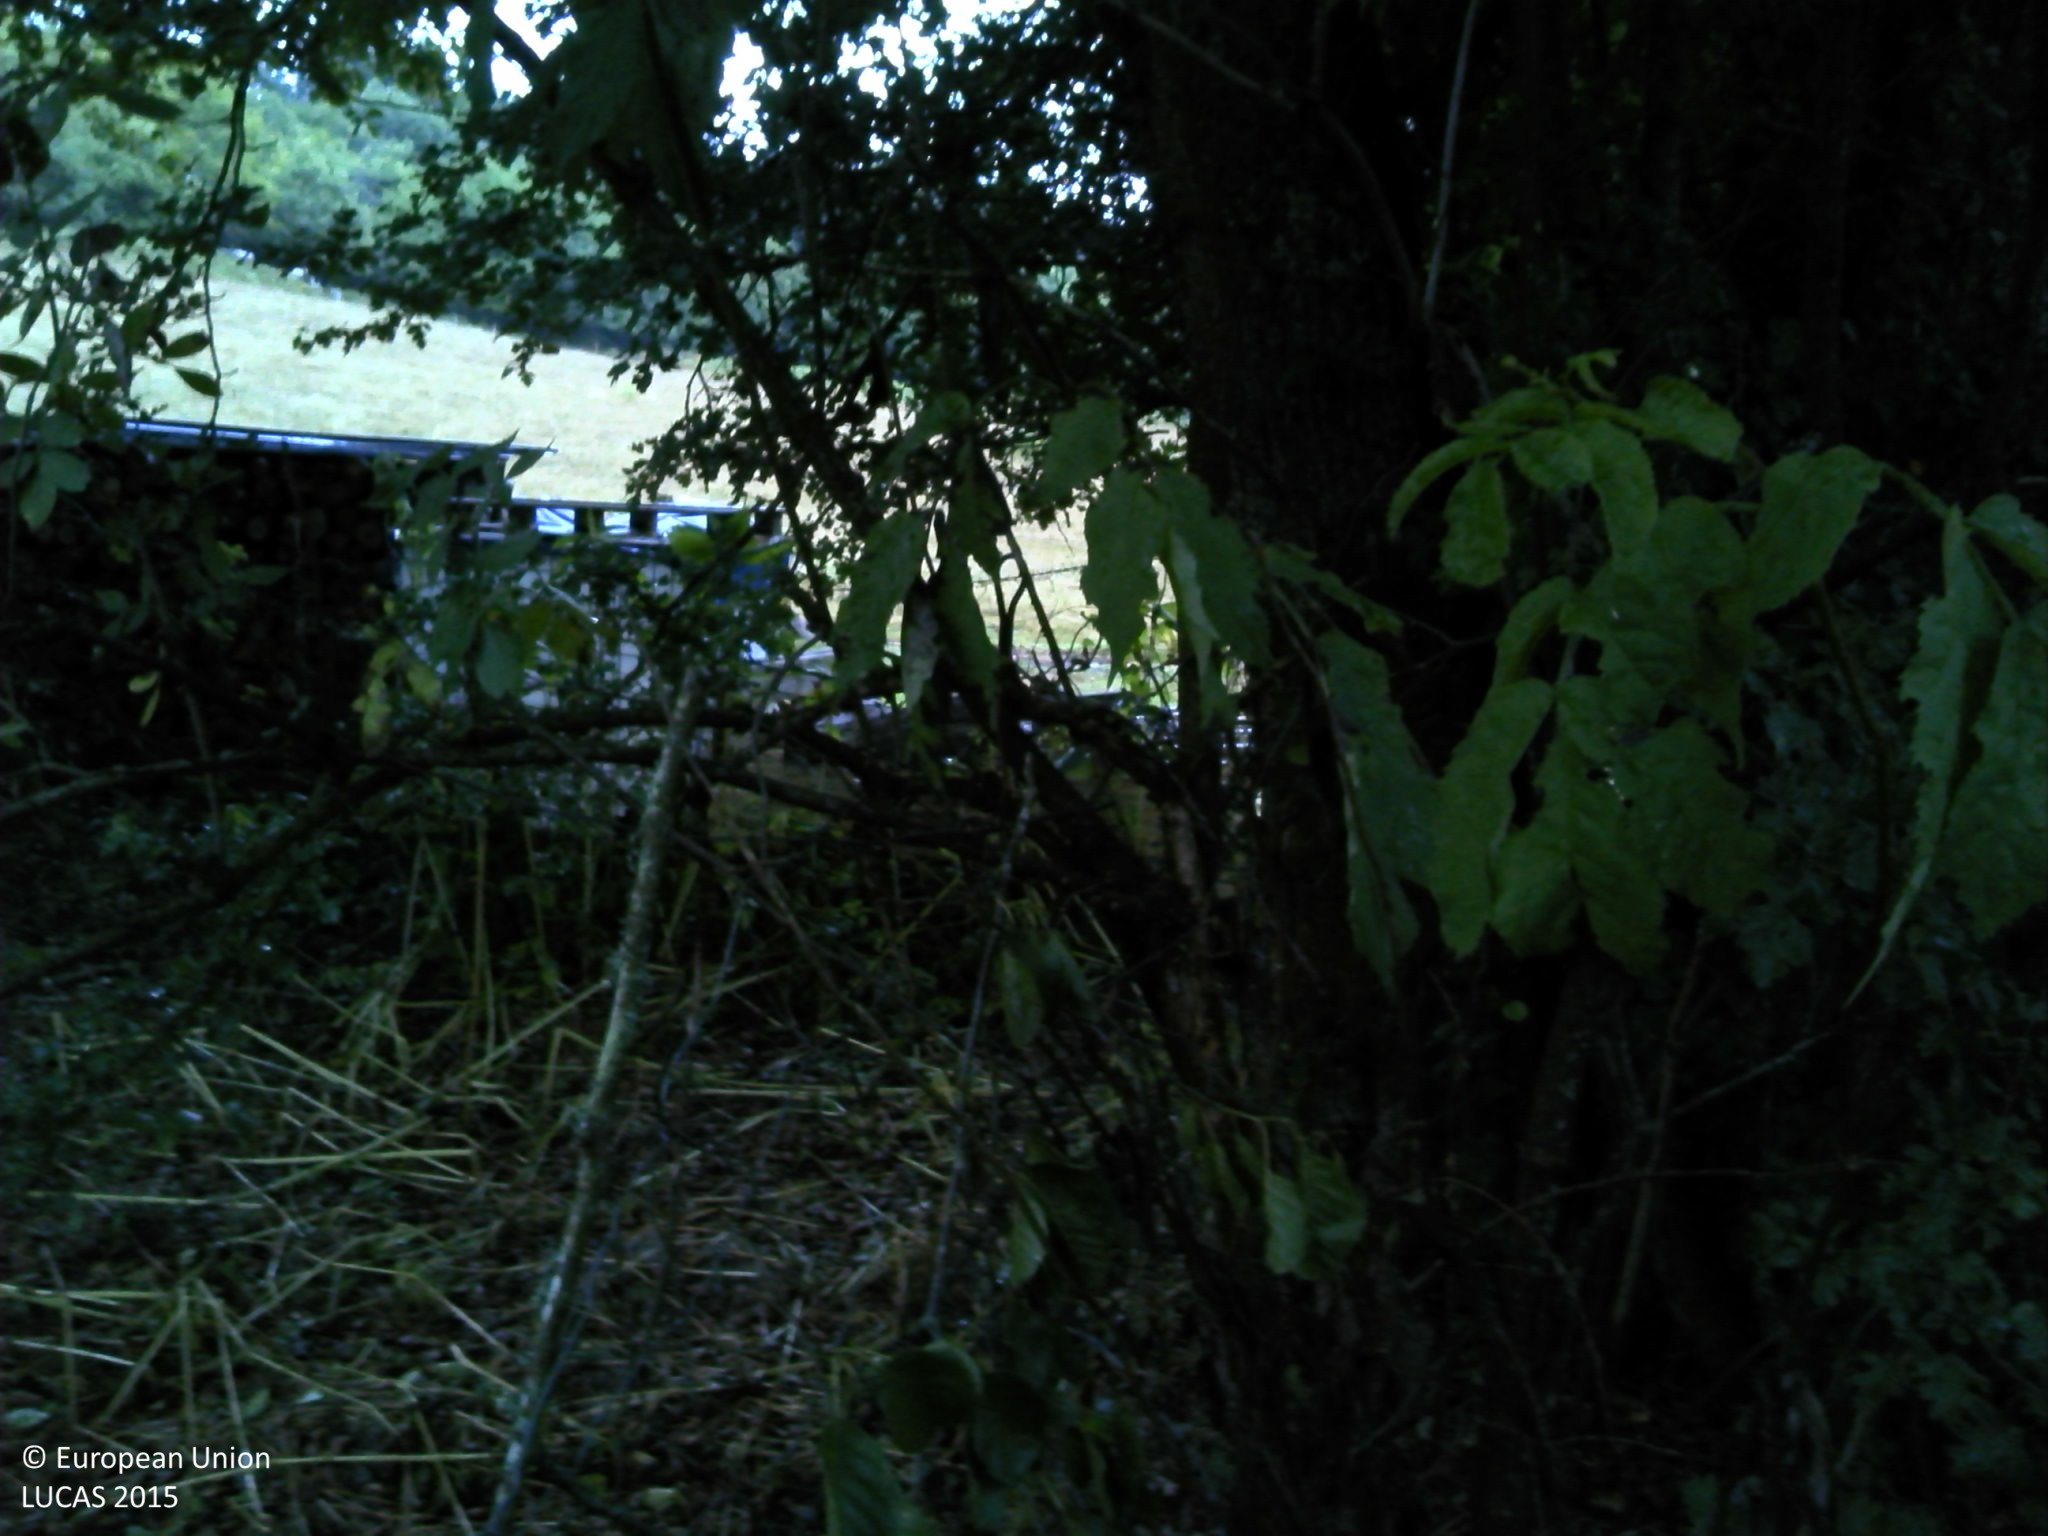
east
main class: Grassland
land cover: Grassland with sparse tree/shrub cover
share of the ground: > 75 %
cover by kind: herbaceous plants 95 %, broadleaved forest trees 5 %
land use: Agriculture (excluding fallow land and kitchen gardens)
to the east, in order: Grassland with sparse tree/shrub cover; Fences; Grassland without tree/shrub cover; Fences; Grassland without tree/shrub cover; Fences; Spruce dominated mixed woodland; Spruce dominated coniferous woodland
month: July
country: FR
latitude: 47.9783
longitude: 6.2095
